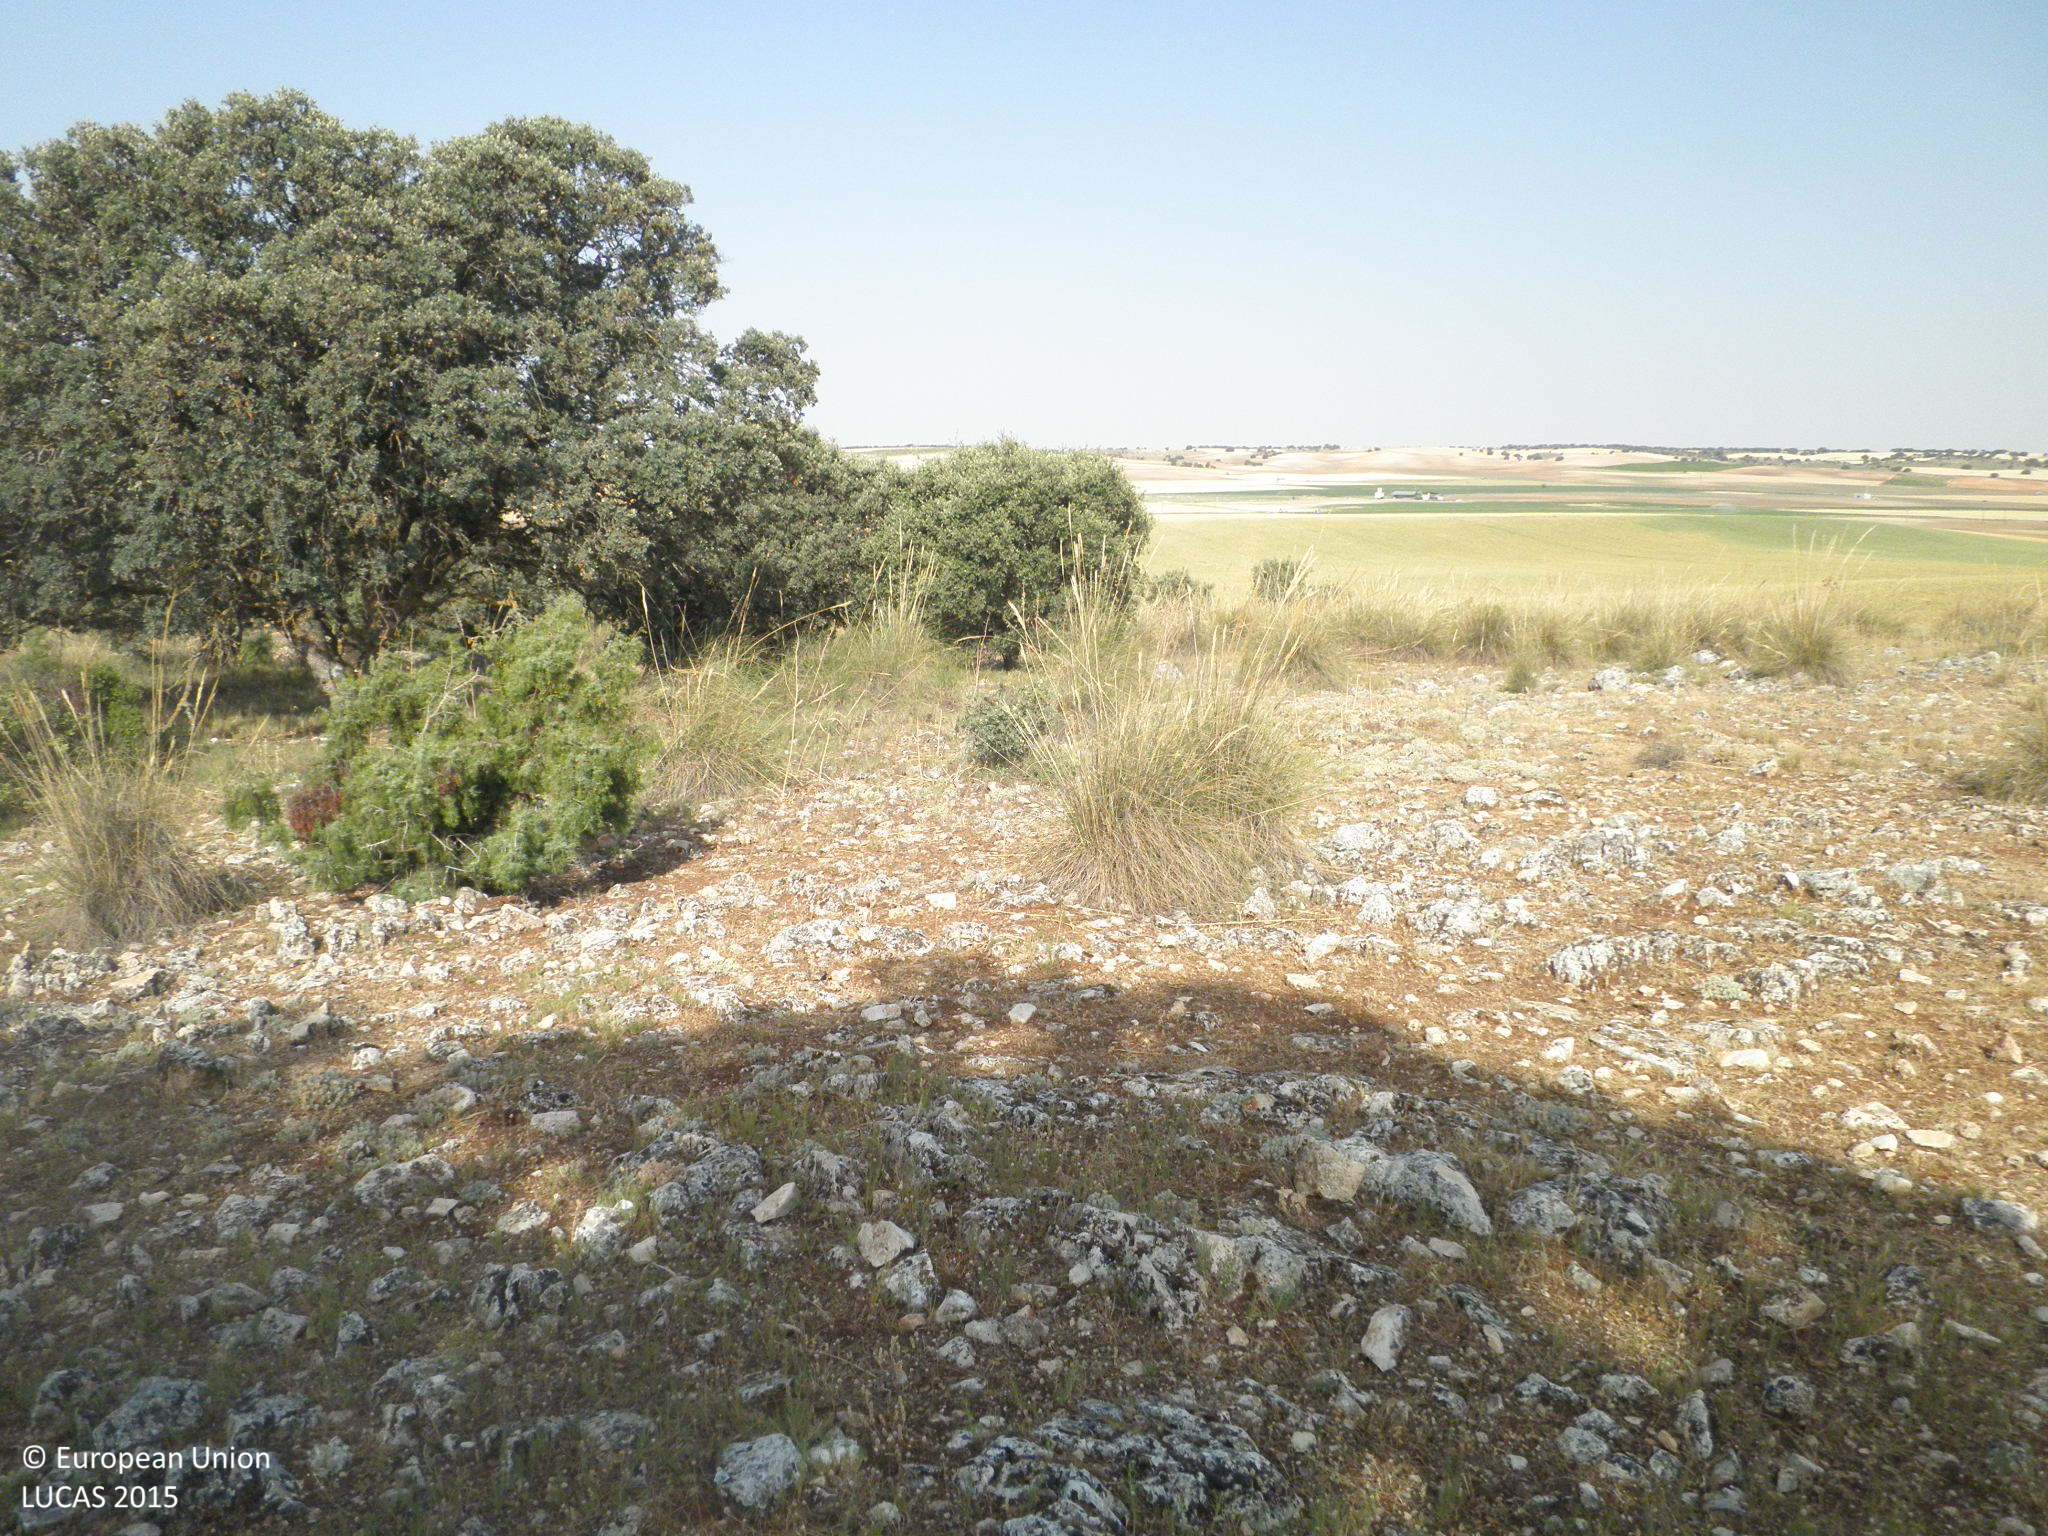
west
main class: Woodland
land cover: Broadleaved woodland
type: broadleaved evergreen forest
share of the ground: 10 - 25 %
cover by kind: herbaceous plants 60 %, consolidated bare surface 20 %, broadleaved forest trees 10 %, shrubs 10 %
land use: Semi-natural and natural areas not in use
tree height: > 5 m
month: July
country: ES
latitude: 39.6153
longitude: -2.6063
